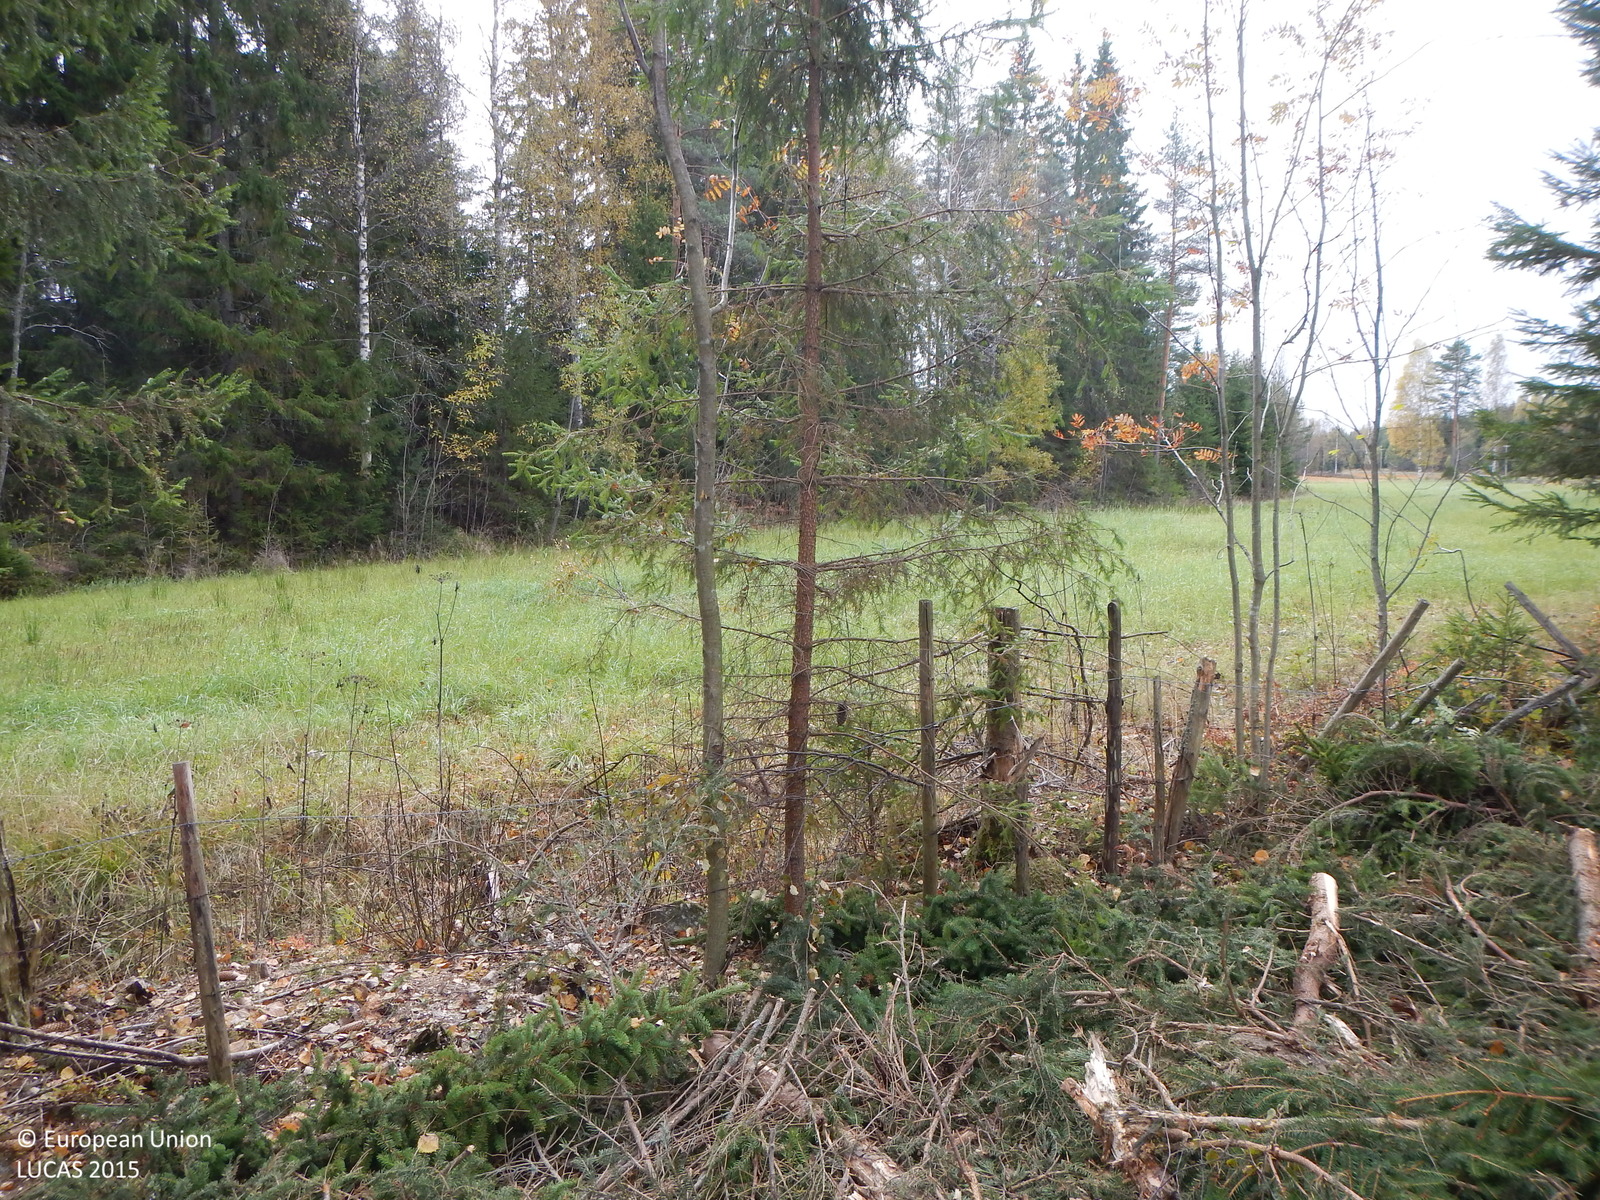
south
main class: Woodland
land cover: Spruce dominated coniferous woodland
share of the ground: > 75 %
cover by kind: coniferous forest trees 75 %, unconsolidated bare surface 20 %, broadleaved forest trees 5 %
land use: Forestry
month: October
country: FI
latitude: 61.7890
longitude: 25.9641
